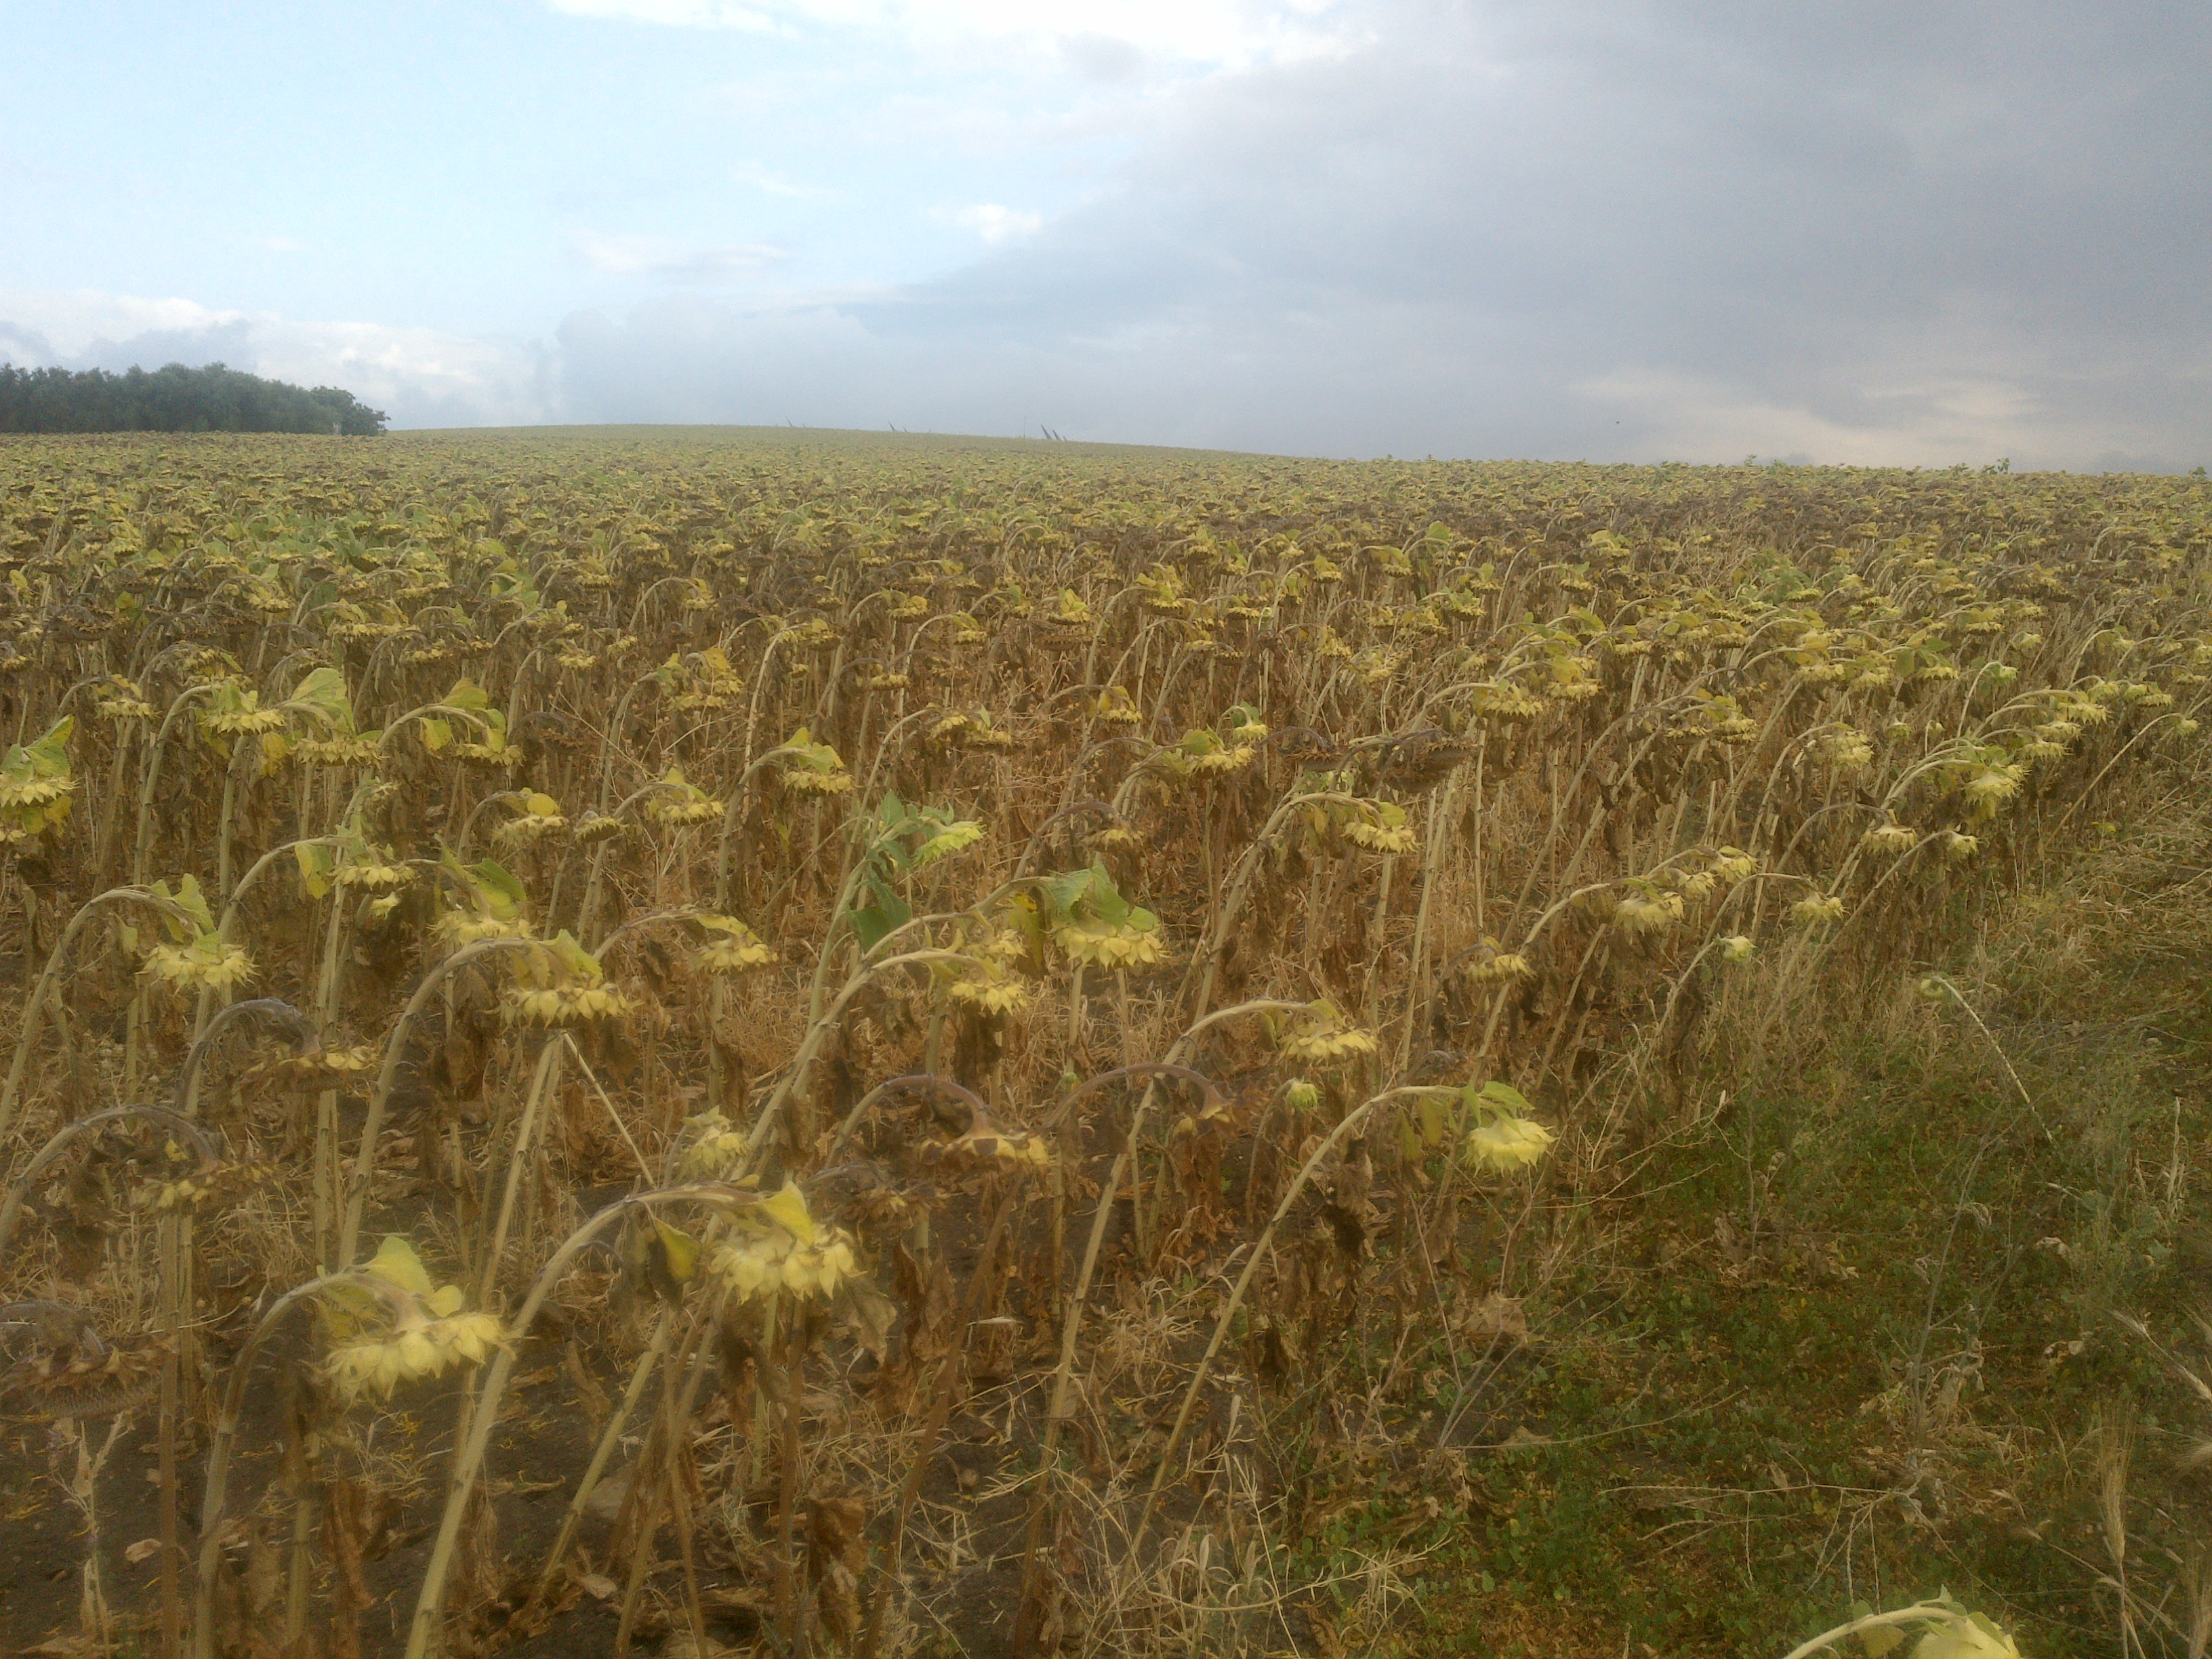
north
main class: Cropland
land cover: Sunflower
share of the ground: > 75 %
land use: Agriculture (excluding fallow land and kitchen gardens)
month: June
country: ES
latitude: 37.9398
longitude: -4.5888
